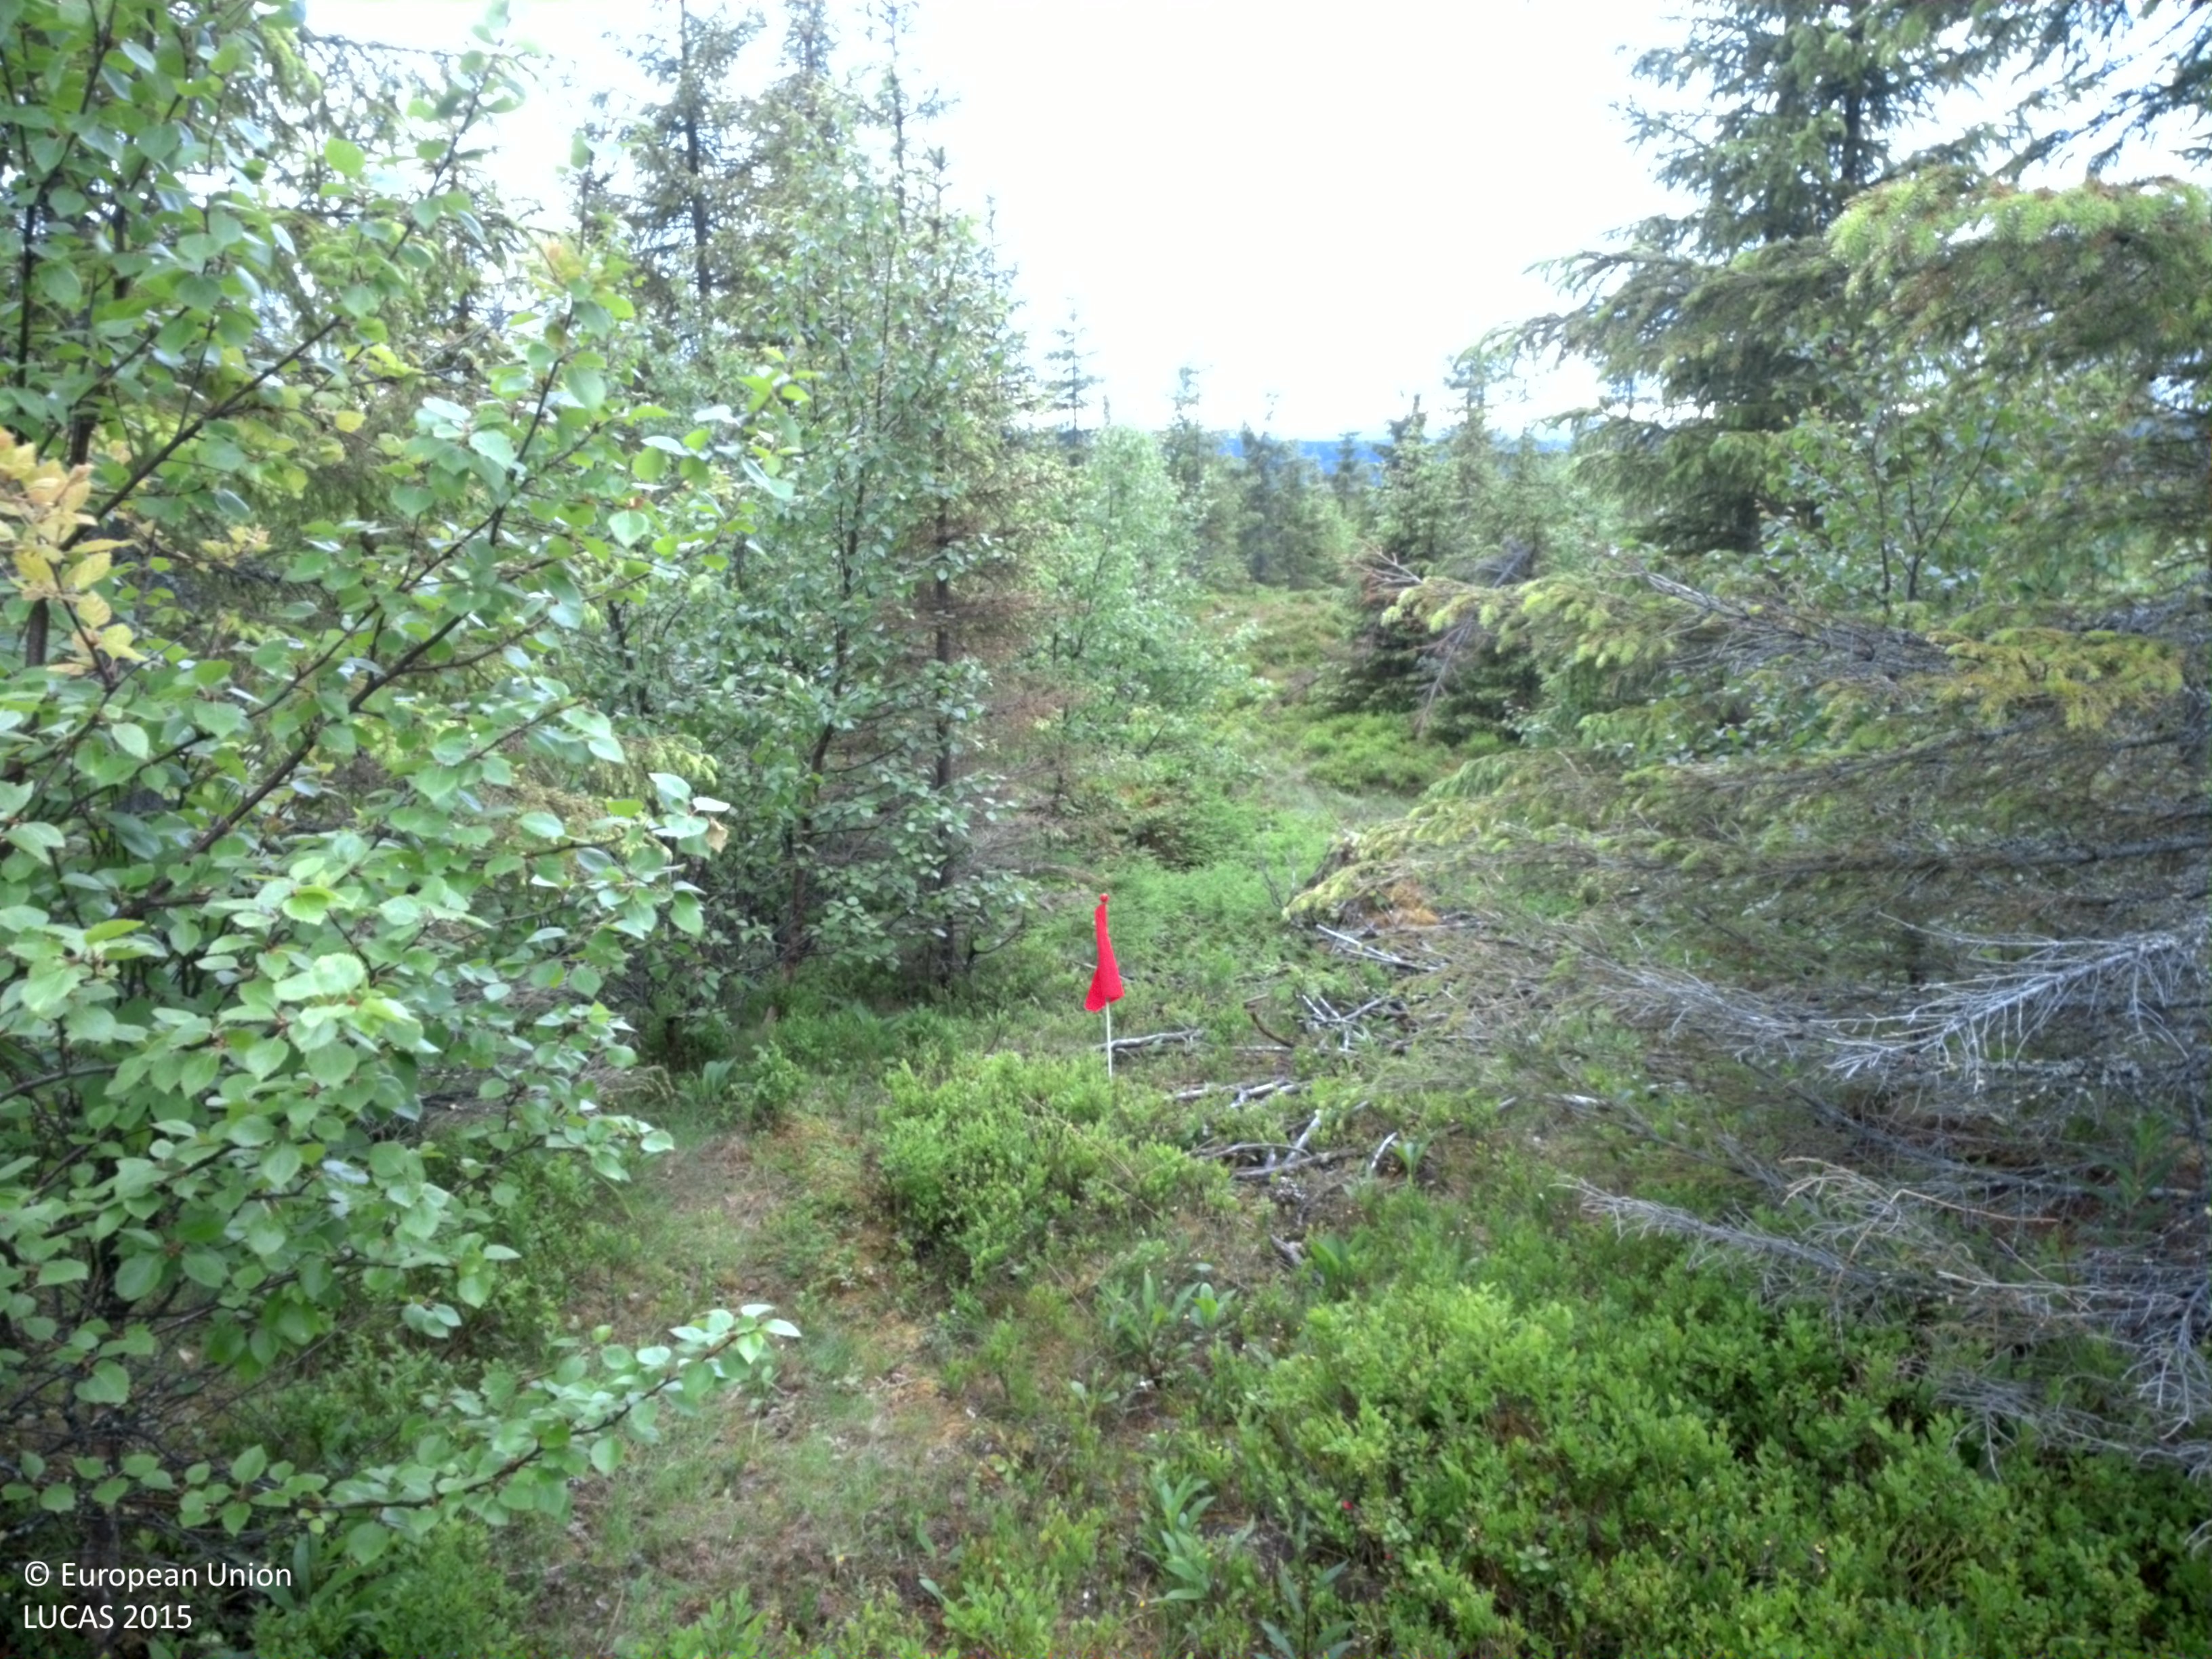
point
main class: Woodland
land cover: Spruce dominated mixed woodland
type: boreal forest
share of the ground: 50 - 75 %
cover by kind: coniferous forest trees 45 %, shrubs 25 %, broadleaved forest trees 15 %, herbaceous plants 15 %
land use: Forestry
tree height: > 5 m
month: July
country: SE
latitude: 64.3922
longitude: 18.0765
